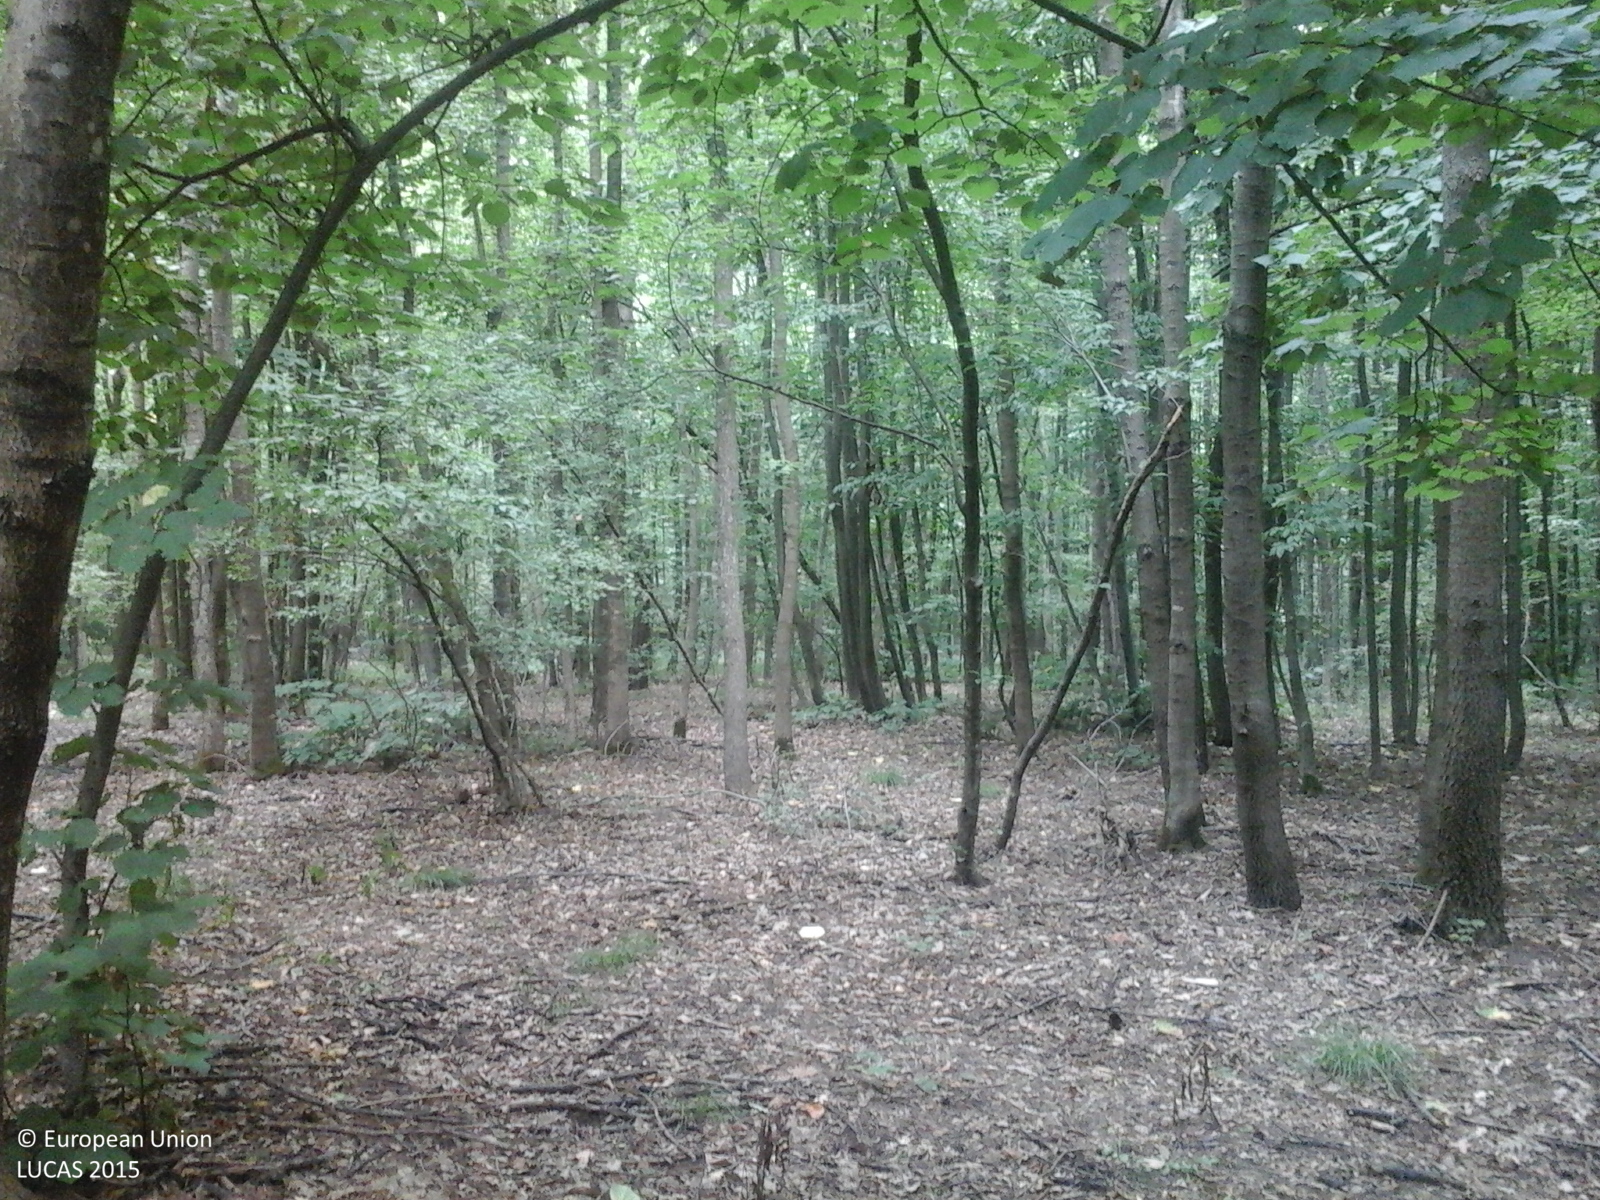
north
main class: Woodland
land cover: Broadleaved woodland
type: mesophytic deciduous forest
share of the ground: > 75 %
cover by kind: broadleaved forest trees 100 %
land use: Forestry
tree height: > 5 m
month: July
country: RO
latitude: 44.4756
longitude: 25.6461
